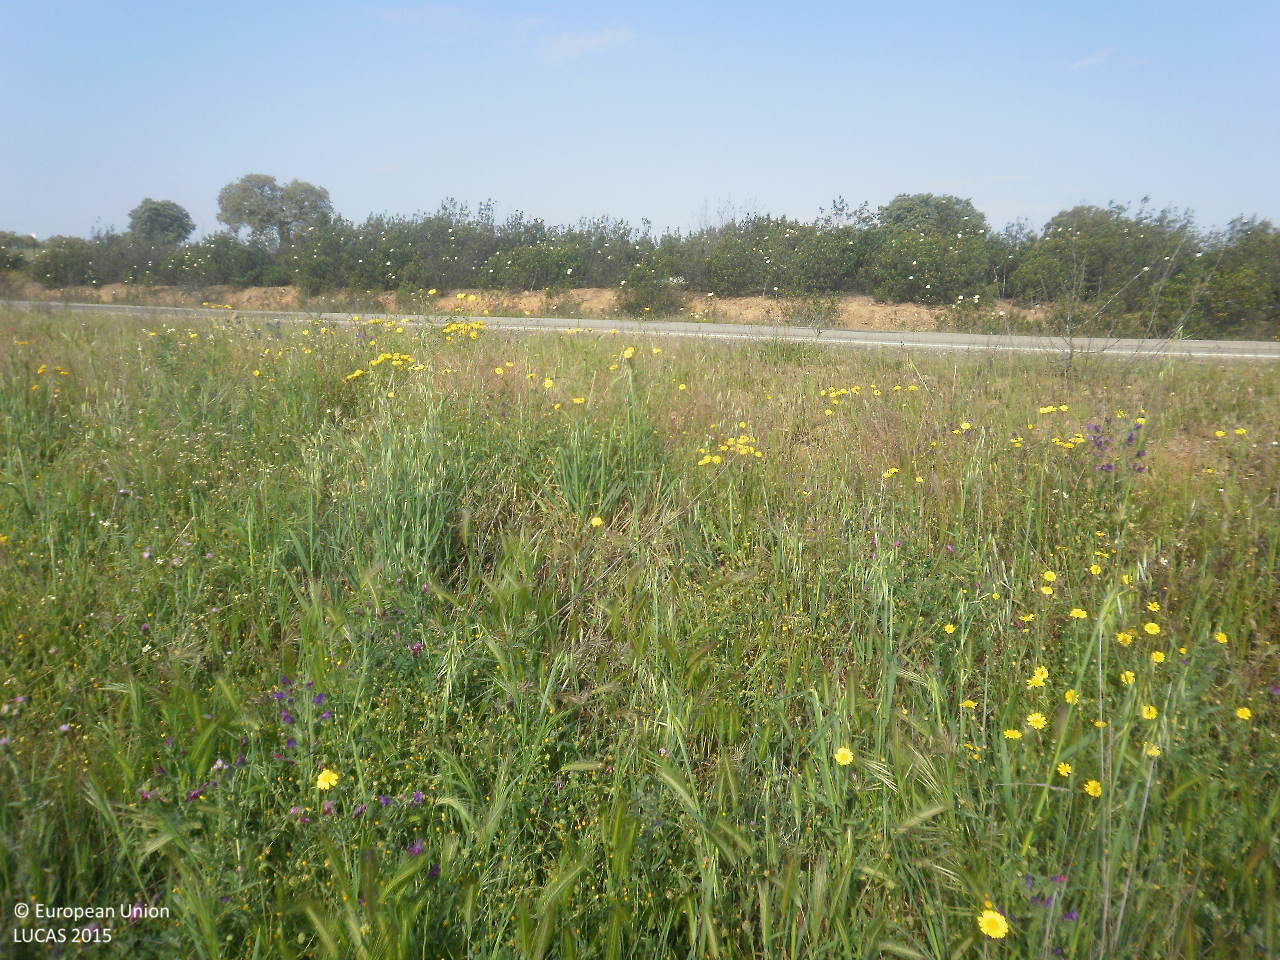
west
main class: Grassland
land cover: Grassland with sparse tree/shrub cover
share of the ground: > 75 %
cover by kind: herbaceous plants 90 %, broadleaved forest trees 5 %, shrubs 5 %
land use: Agriculture (excluding fallow land and kitchen gardens)
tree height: > 5 m
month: April
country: ES
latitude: 38.7641
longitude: -5.1916
